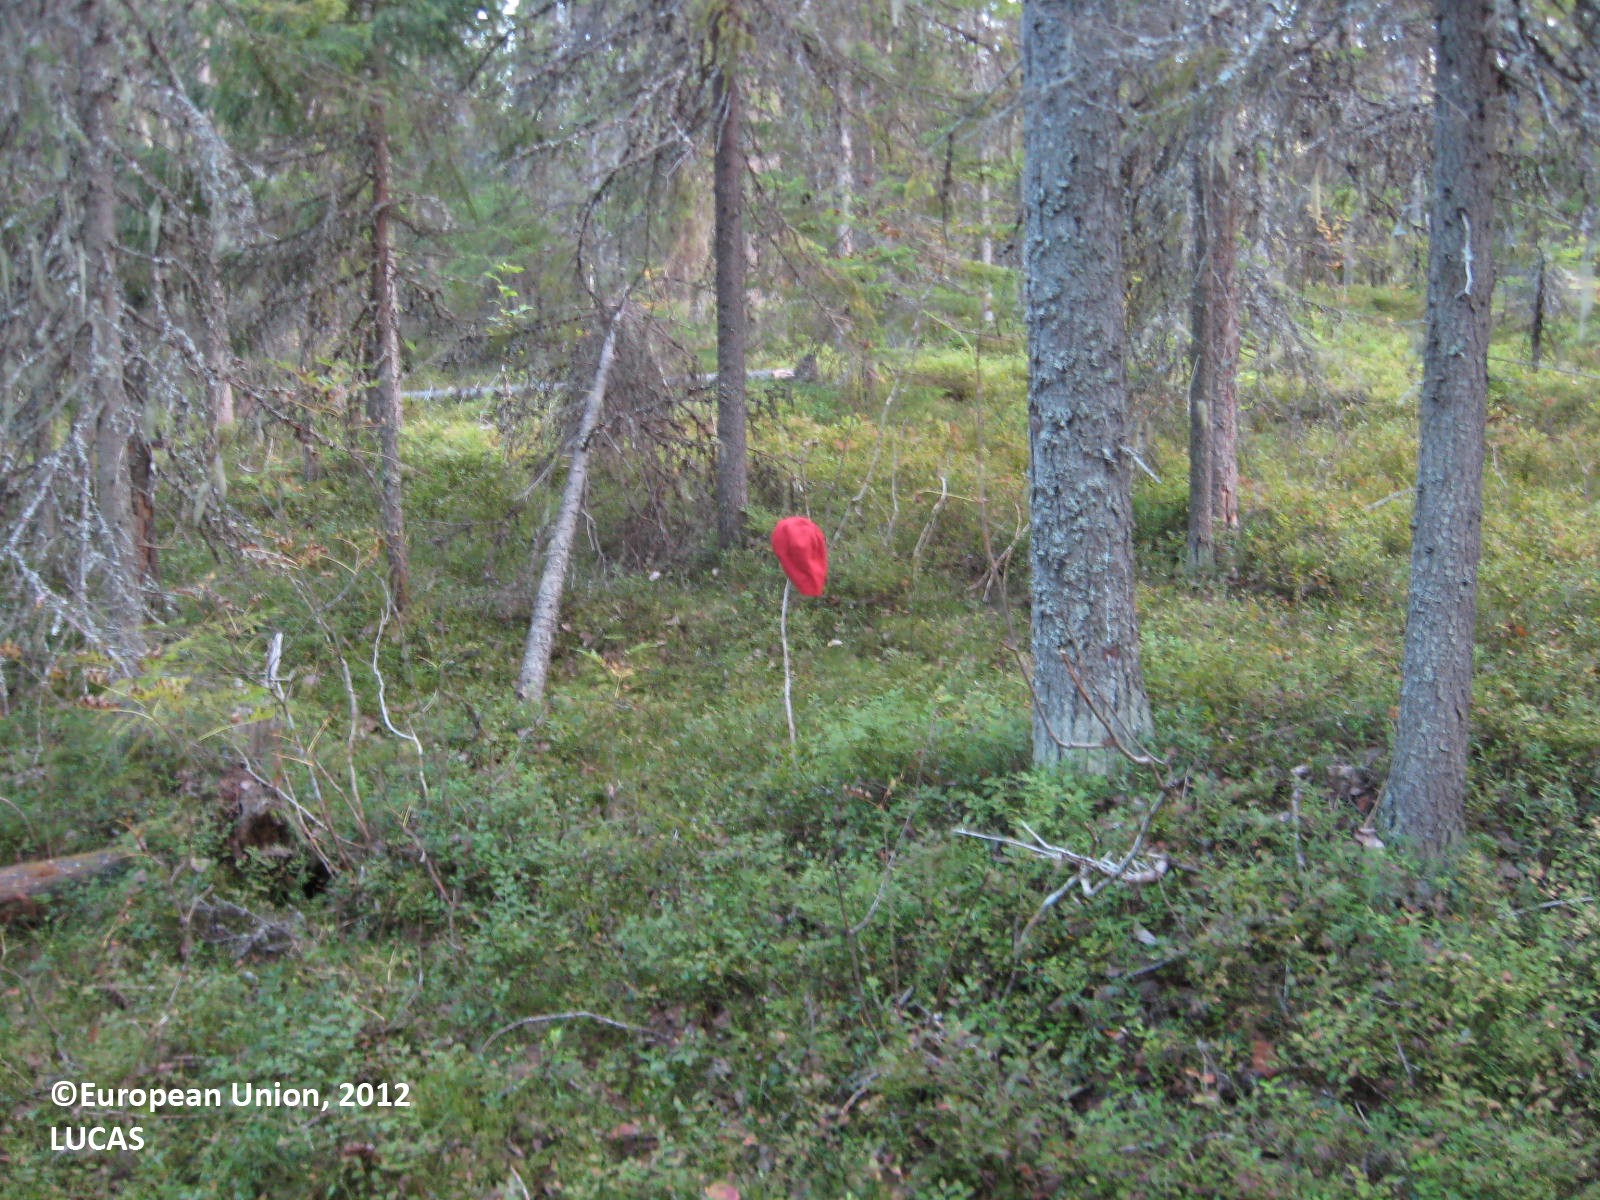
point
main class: Woodland
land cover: Other coniferous woodland
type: boreal forest
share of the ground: > 75 %
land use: Forestry
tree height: > 5 m
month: August
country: FI
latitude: 63.8789
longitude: 29.7982
